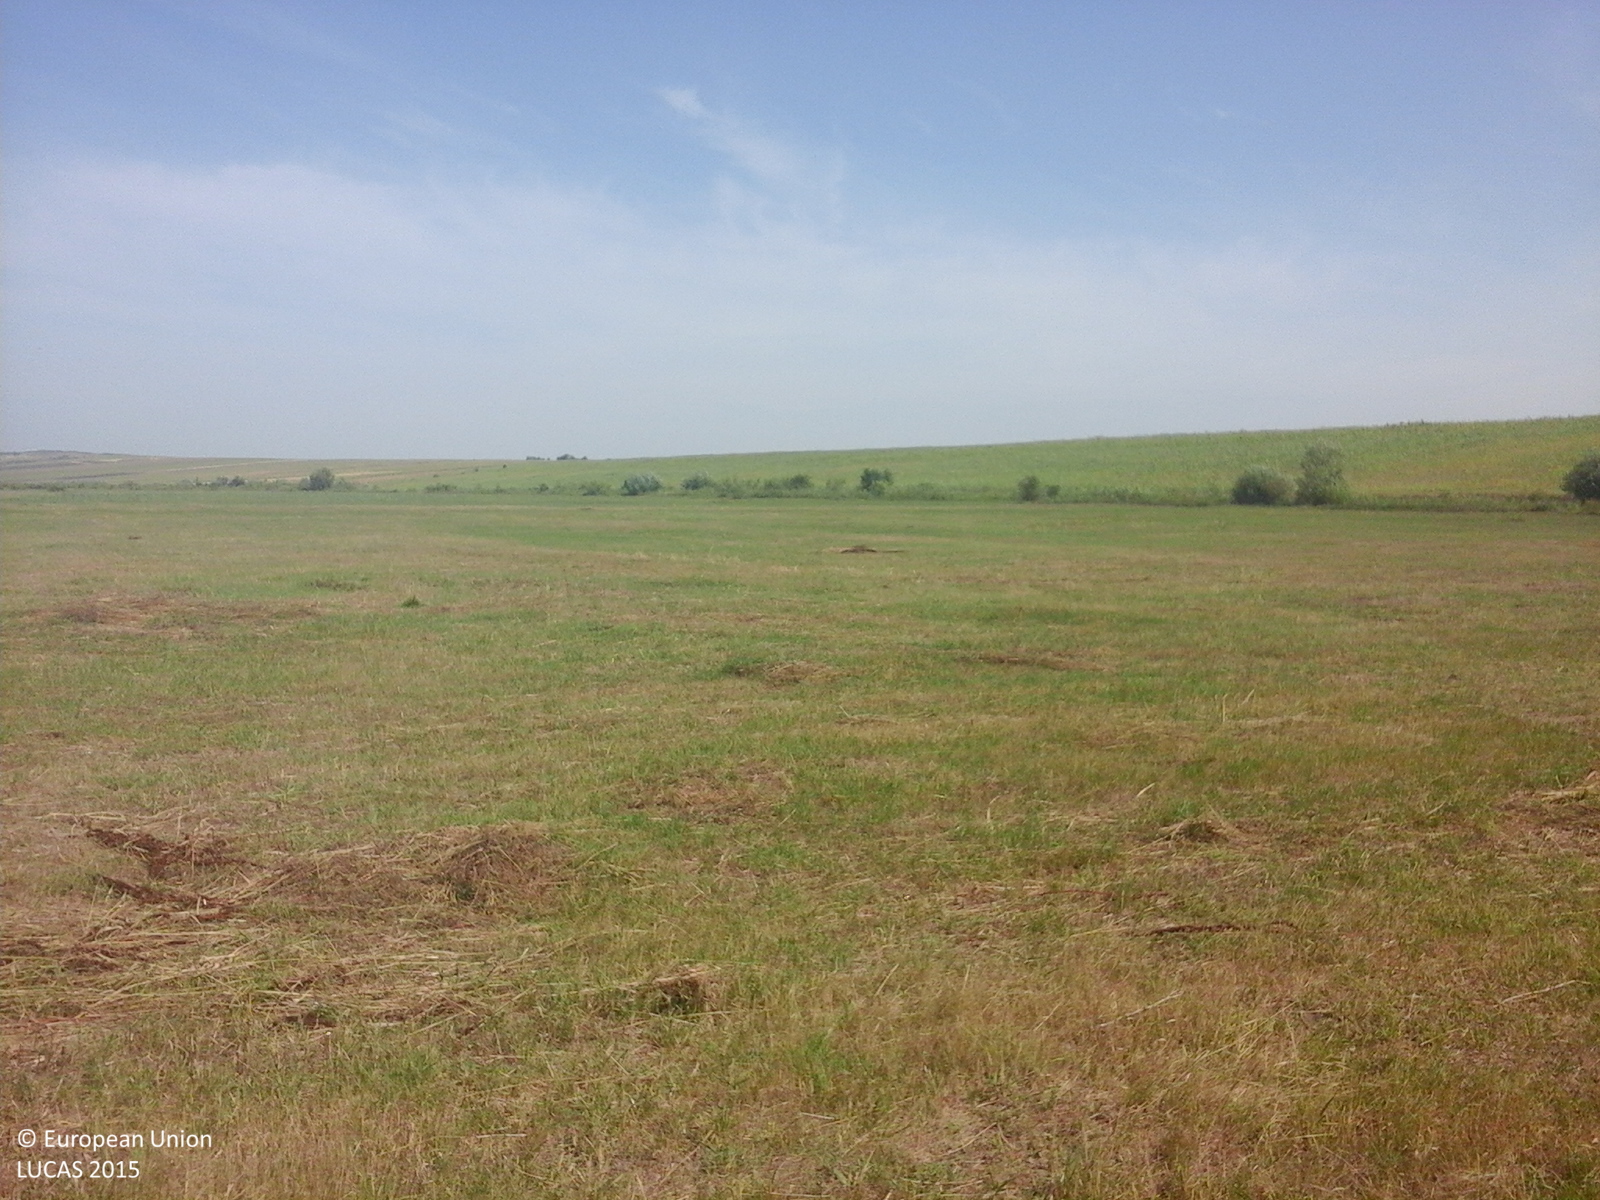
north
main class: Grassland
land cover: Grassland without tree/shrub cover
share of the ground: > 75 %
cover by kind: herbaceous plants 100 %
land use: Agriculture (excluding fallow land and kitchen gardens)
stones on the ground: 10 - 25 %
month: July
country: RO
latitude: 46.5401
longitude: 28.1123
